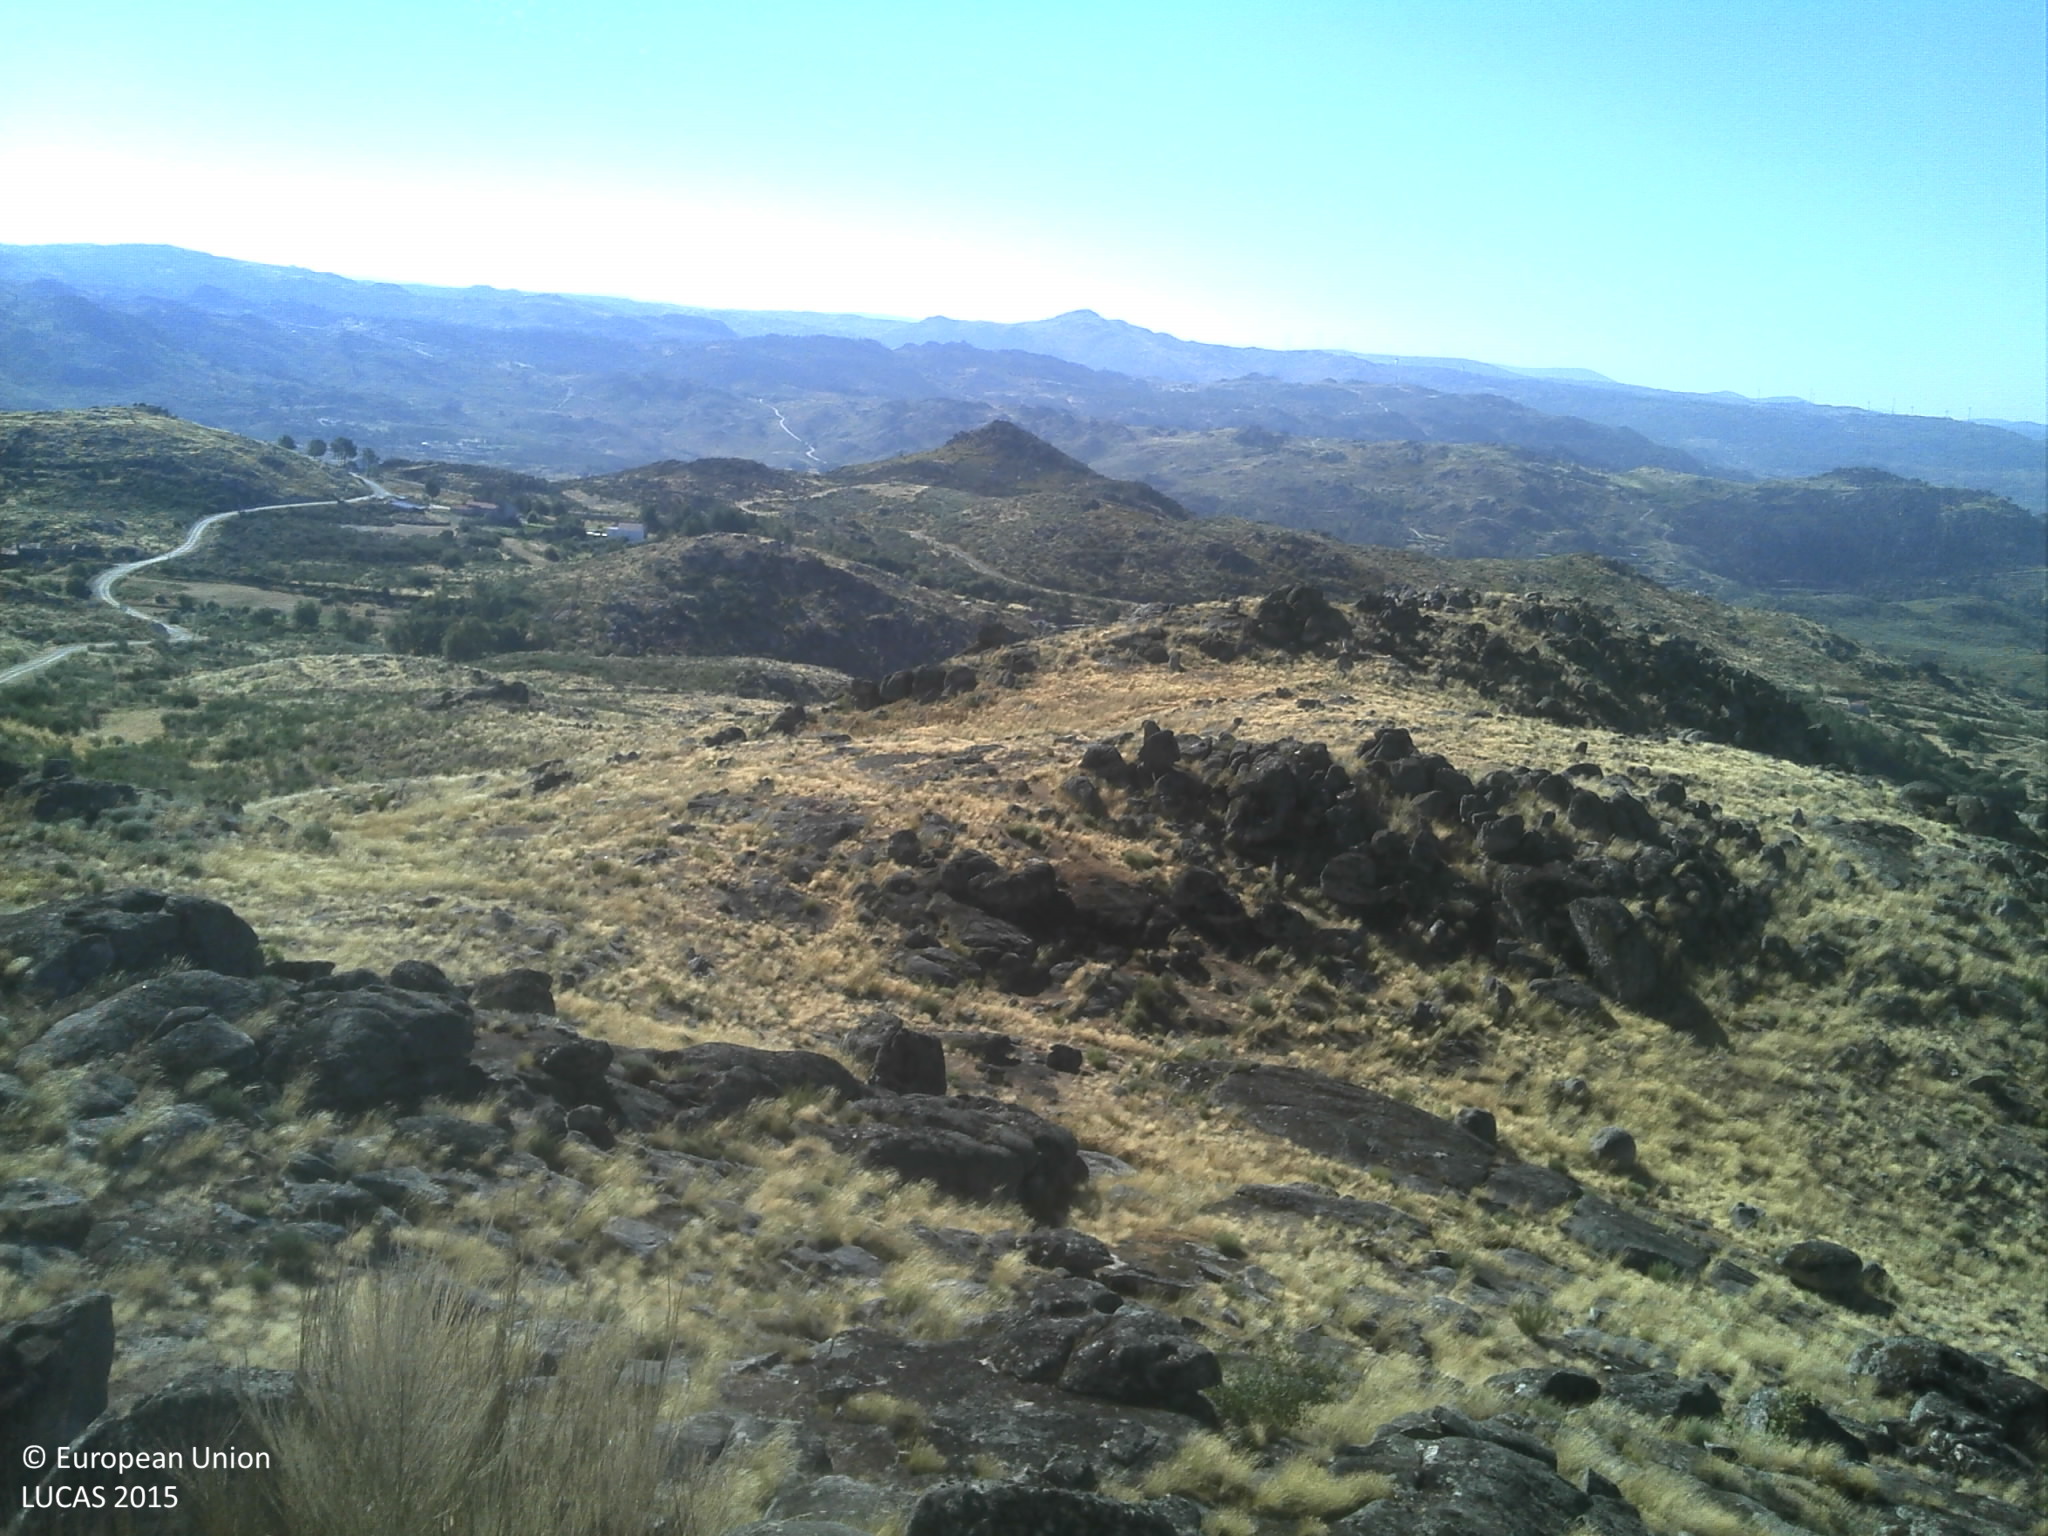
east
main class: Shrubland
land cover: Shrubland without tree cover
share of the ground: 50 - 75 %
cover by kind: shrubs 60 %, unconsolidated bare surface 20 %, herbaceous plants 10 %
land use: Semi-natural and natural areas not in use
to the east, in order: Shrubland without tree cover; Rocks and stones; Shrubland without tree cover; Rocks and stones
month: July
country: PT
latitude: 40.4013
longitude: -7.2708
